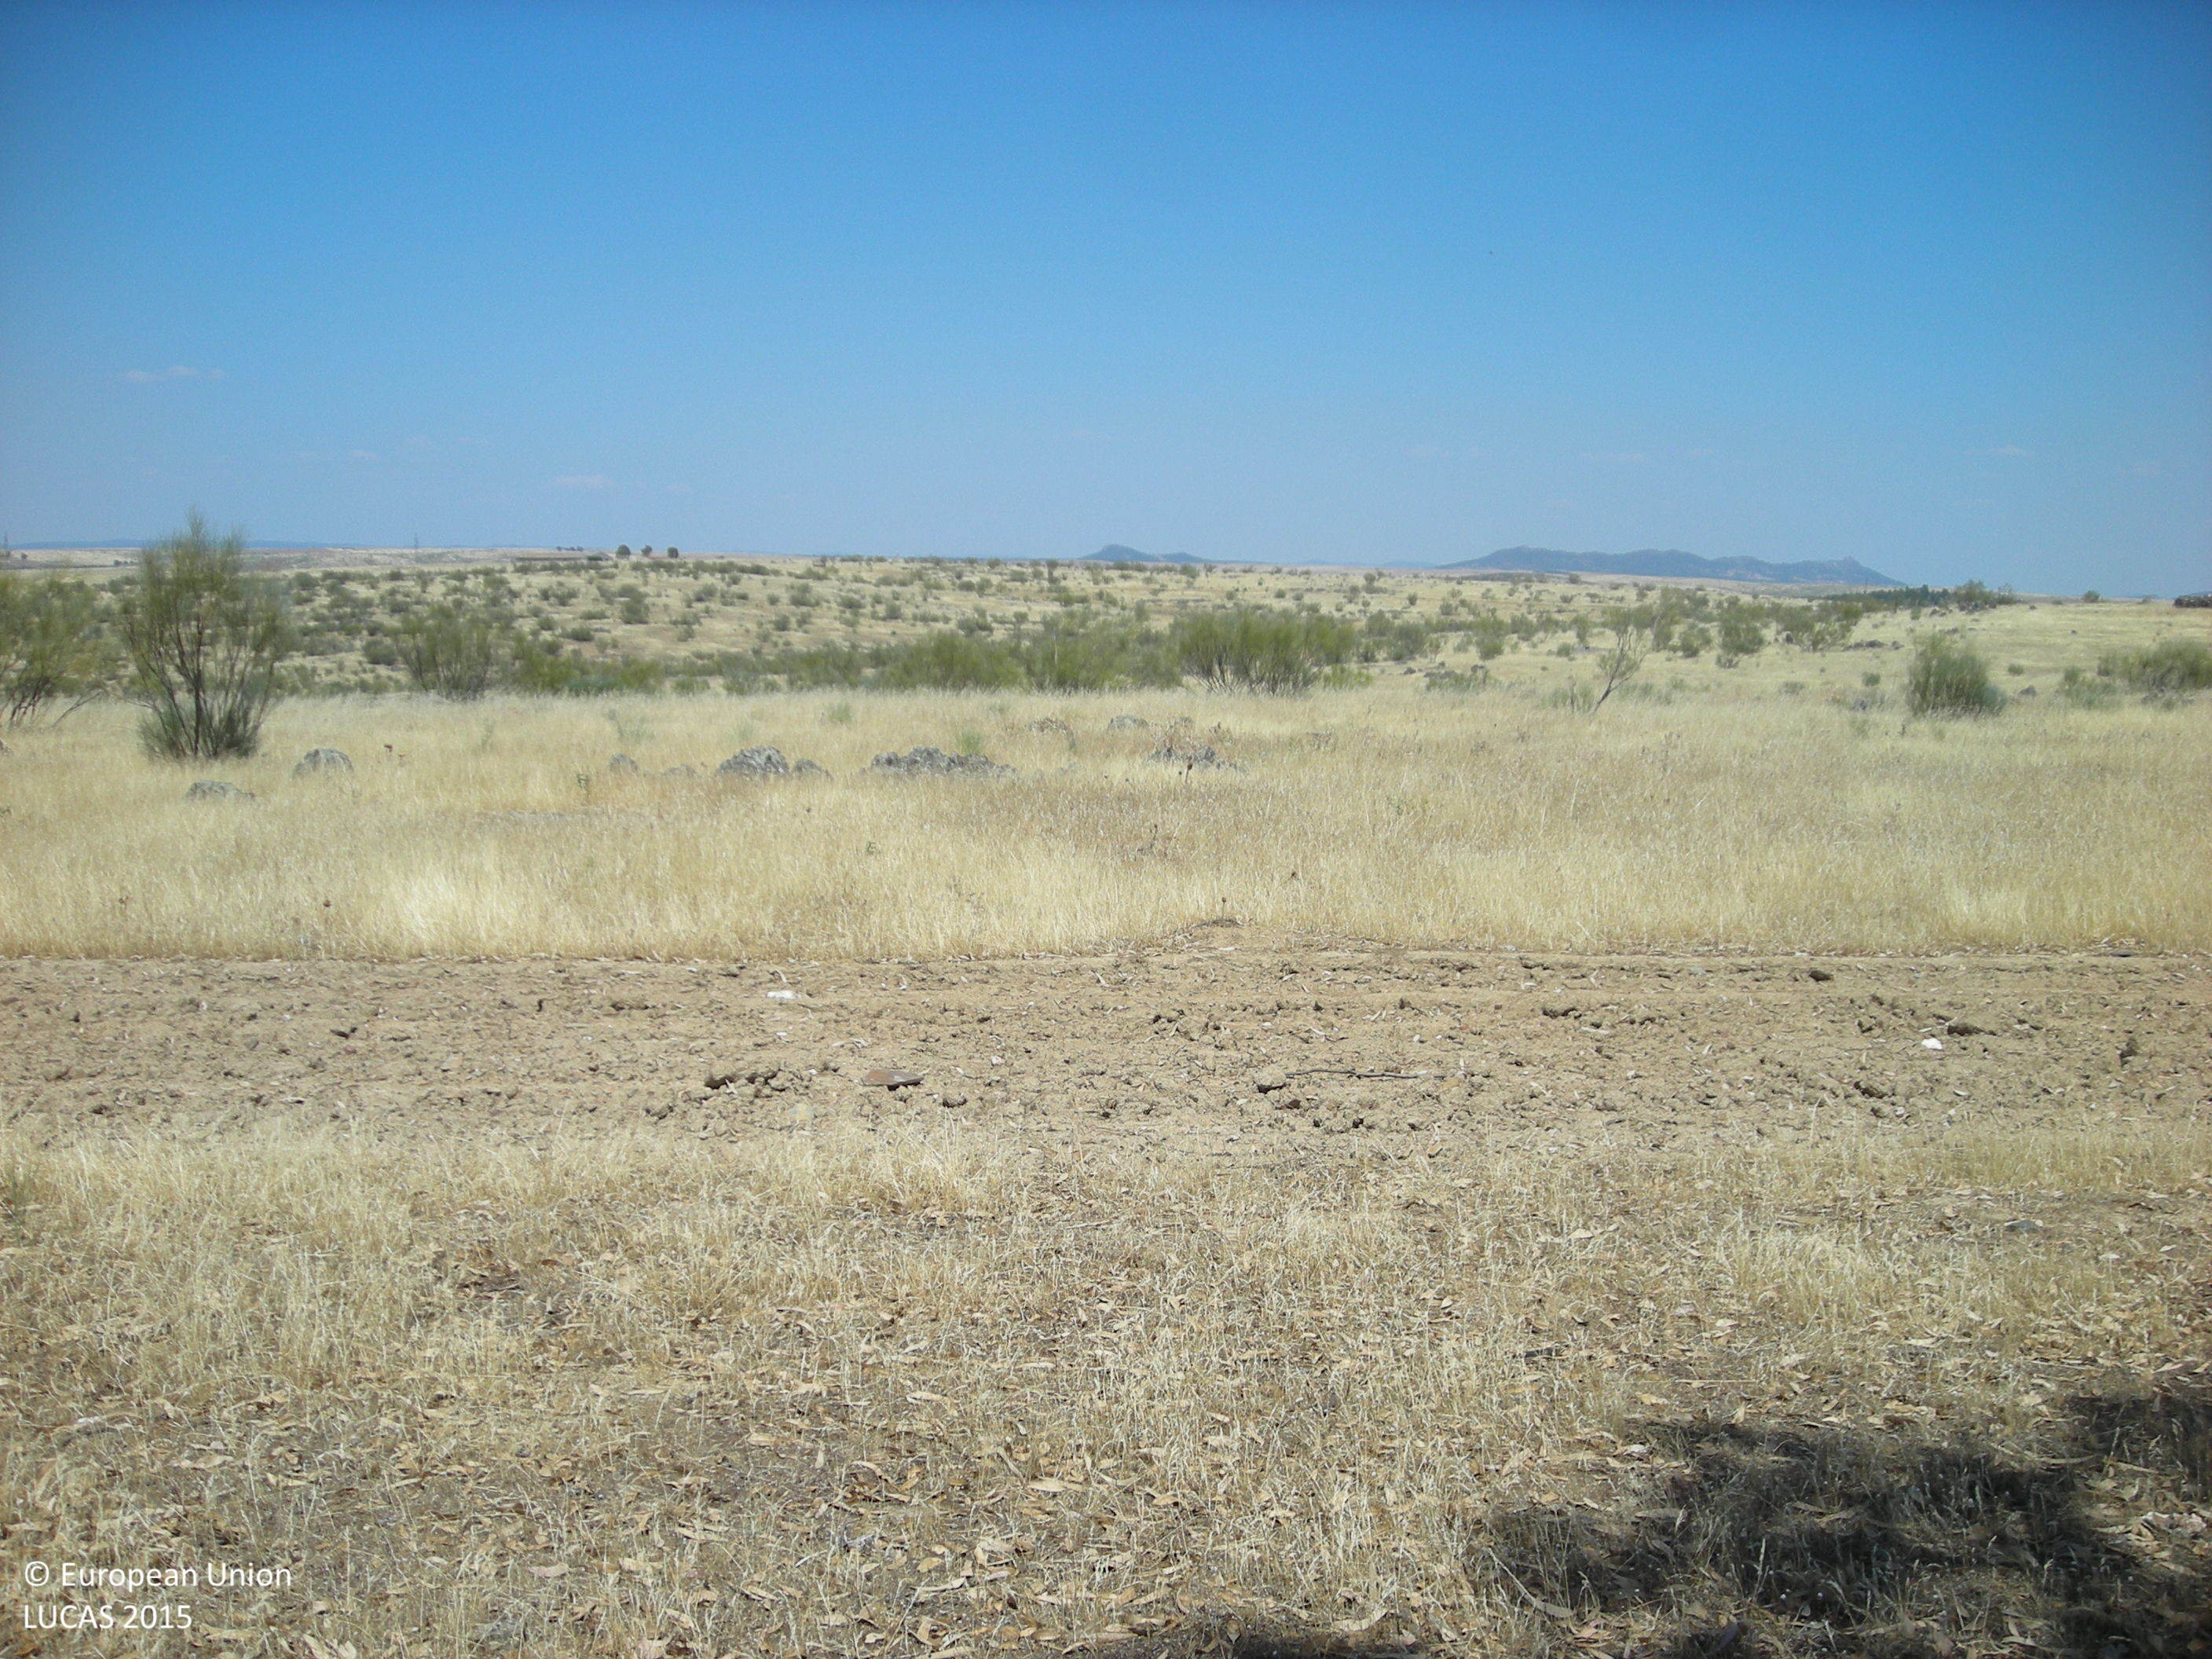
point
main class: Grassland
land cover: Grassland without tree/shrub cover
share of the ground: > 75 %
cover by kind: herbaceous plants 100 %
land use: Agriculture (excluding fallow land and kitchen gardens)
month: June
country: ES
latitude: 38.9050
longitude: -5.4588
